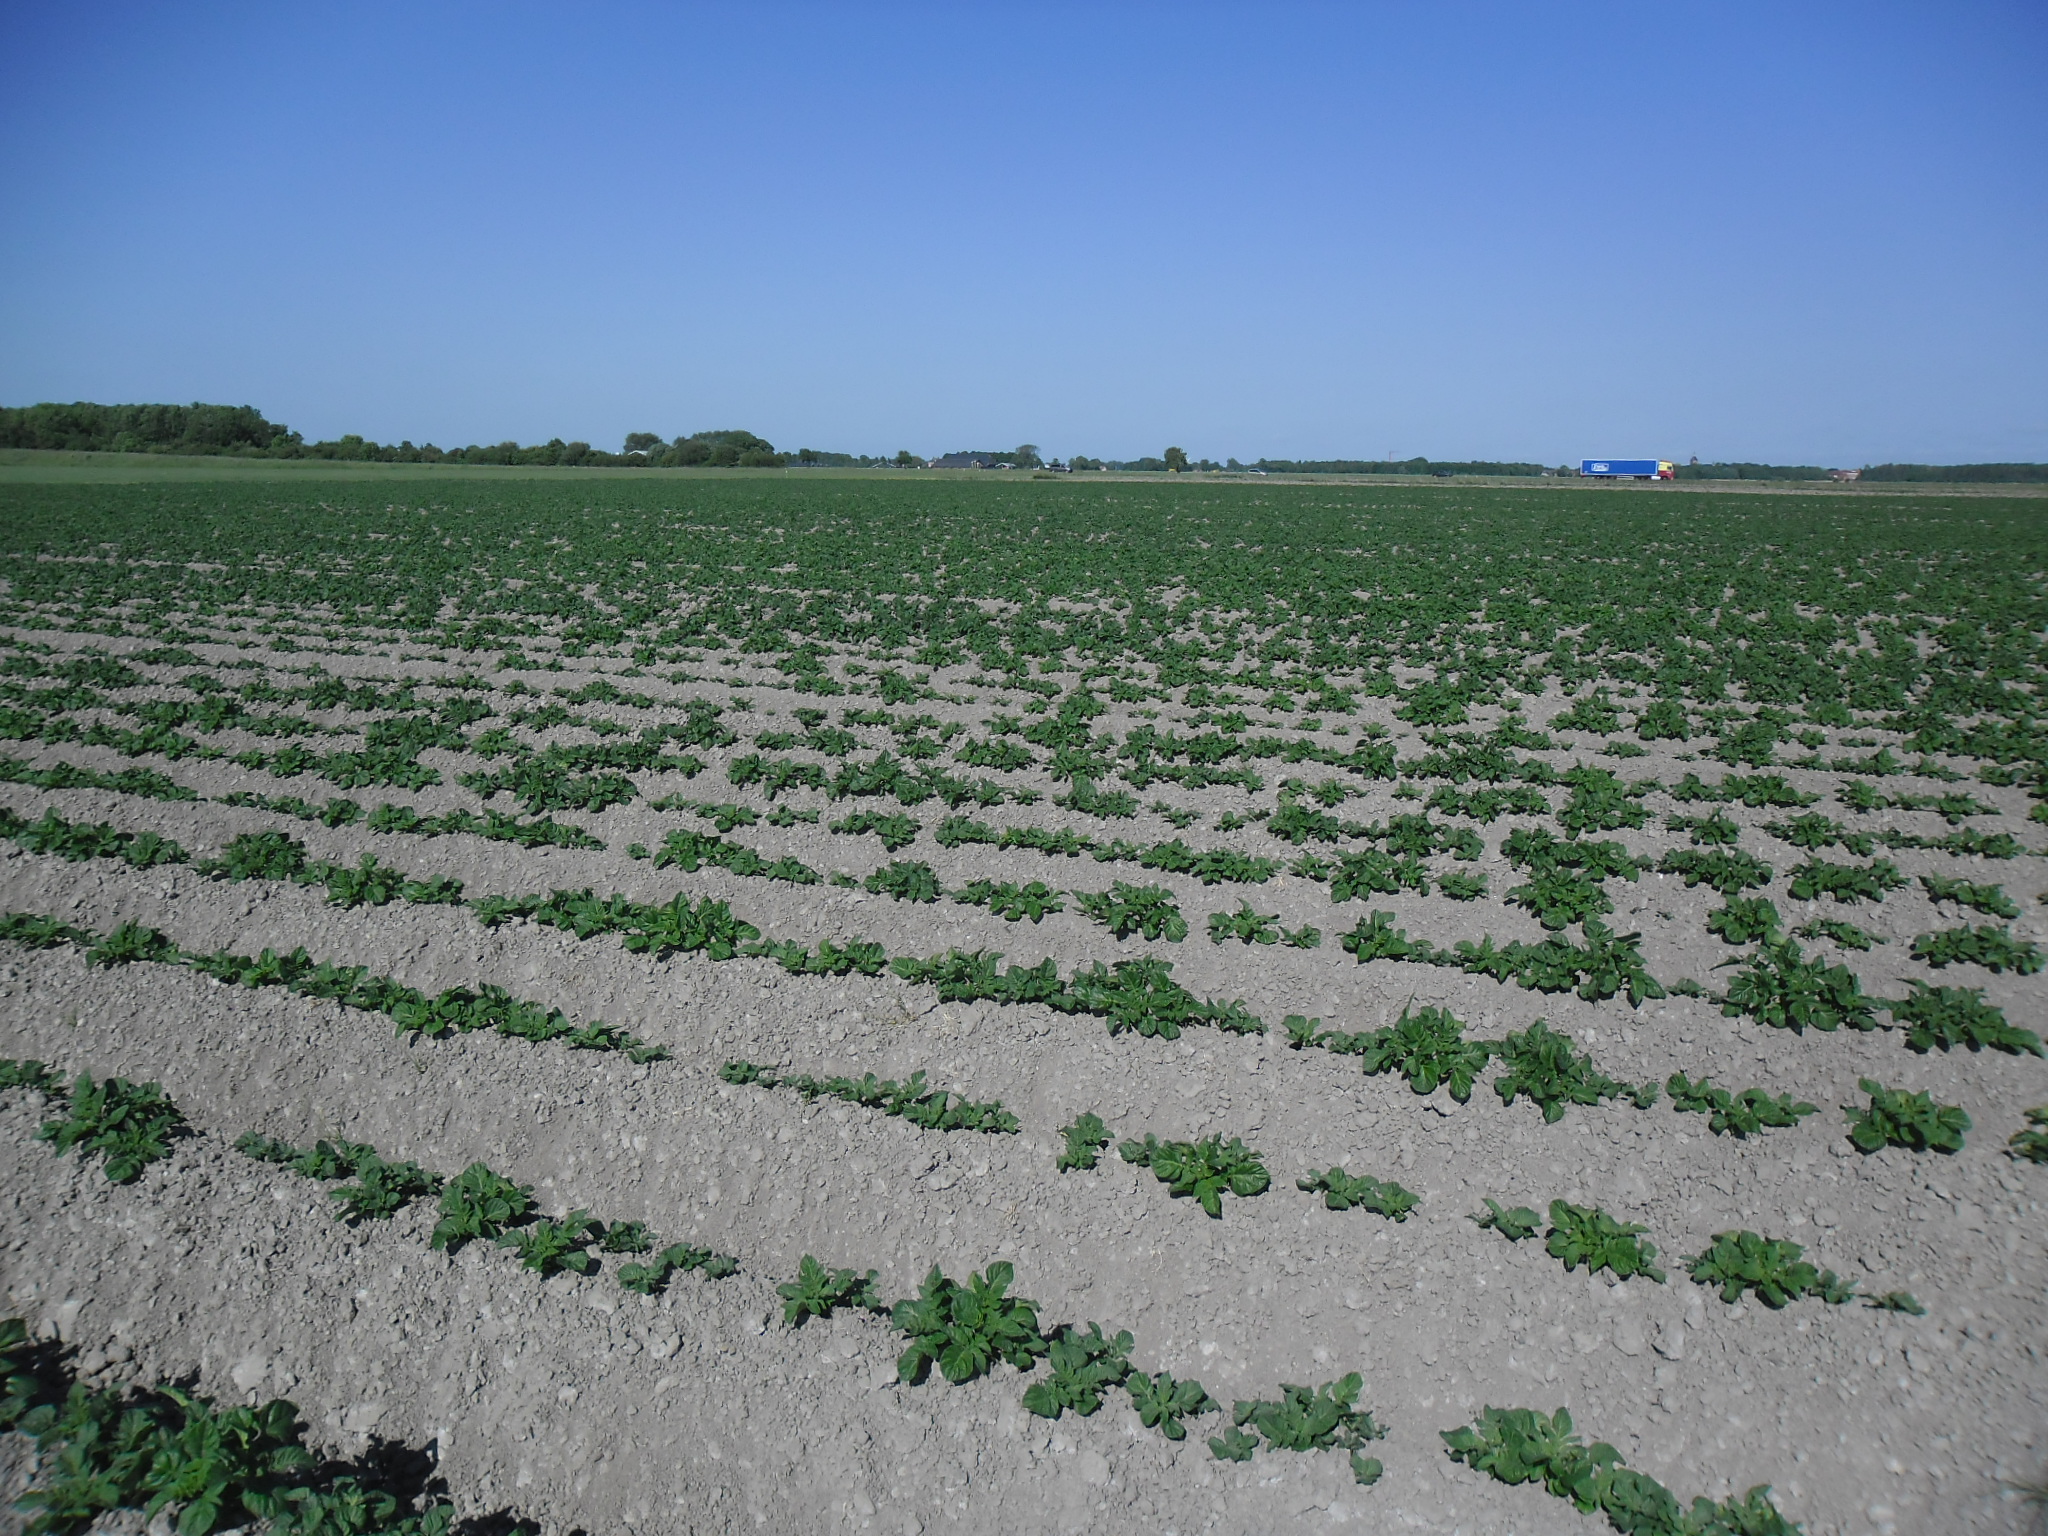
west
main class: Cropland
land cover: Potatoes
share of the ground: < 10 %
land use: Agriculture (excluding fallow land and kitchen gardens)
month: June
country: NL
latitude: 53.3385
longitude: 6.6812
